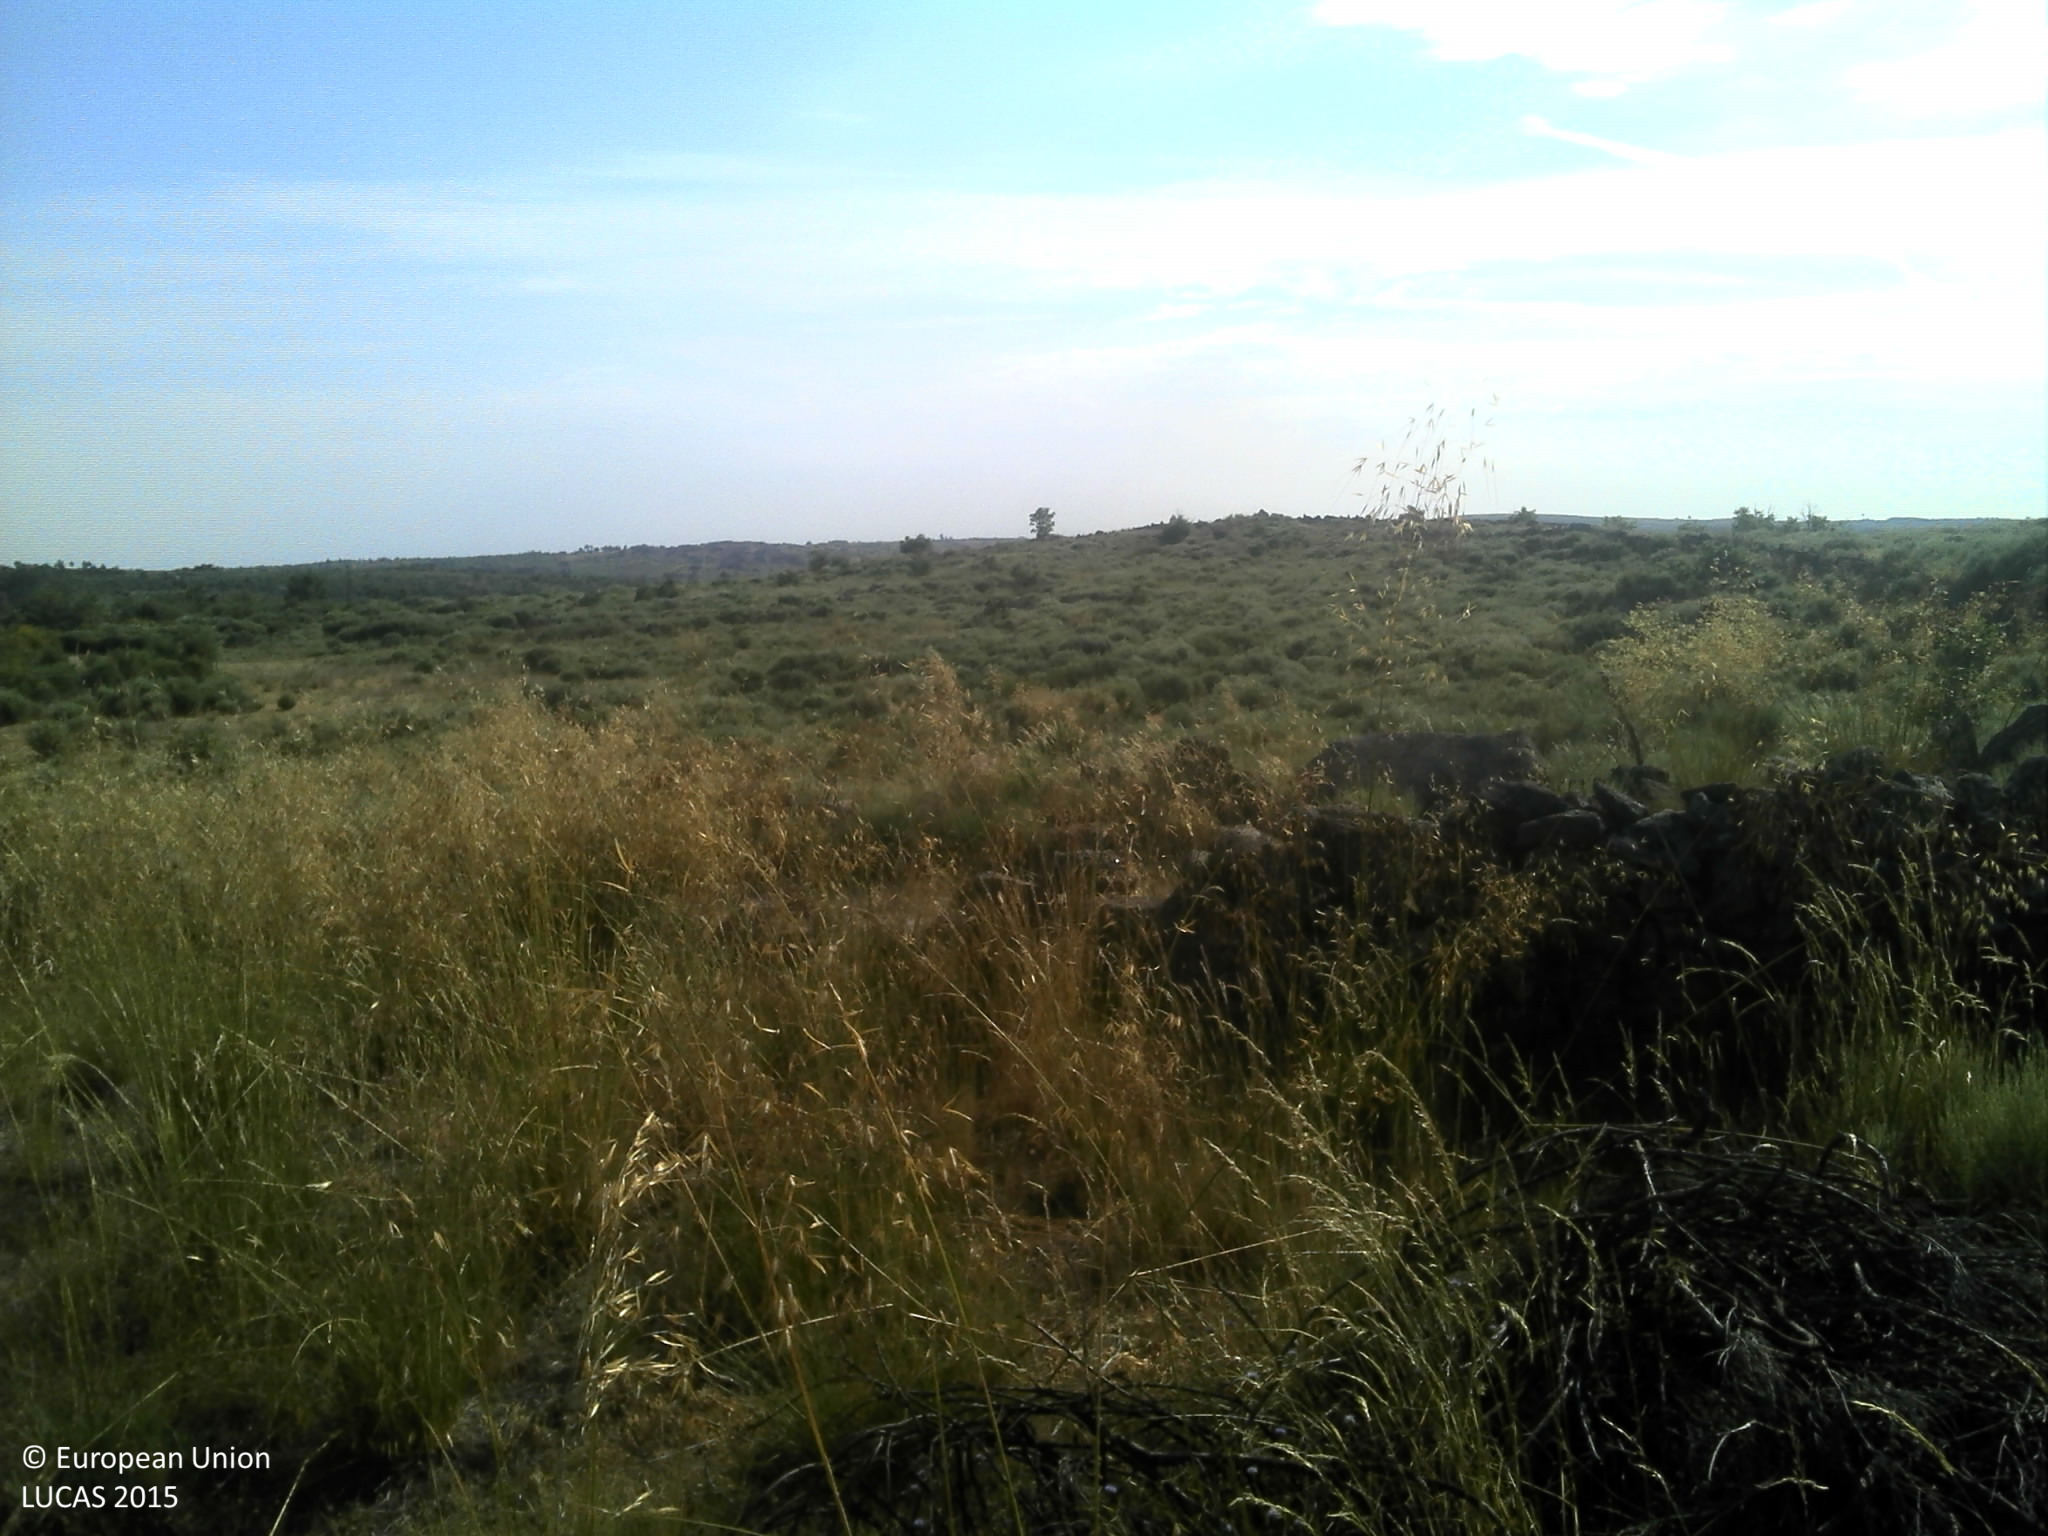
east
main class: Shrubland
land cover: Shrubland without tree cover
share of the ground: 50 - 75 %
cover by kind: shrubs 70 %, herbaceous plants 15 %, unconsolidated bare surface 15 %
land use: Semi-natural and natural areas not in use
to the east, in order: Shrubland without tree cover; Dry stone walls; Tracks; Shrubland without tree cover; Dry stone walls; Shrubland without tree cover; Dry stone walls; Shrubland without tree cover; Dry stone walls; Shrubland without tree cover; Dry stone walls; Shrubland without tree cover; Dry stone walls; Shrubland without tree cover
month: June
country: PT
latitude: 40.3690
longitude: -7.1412
